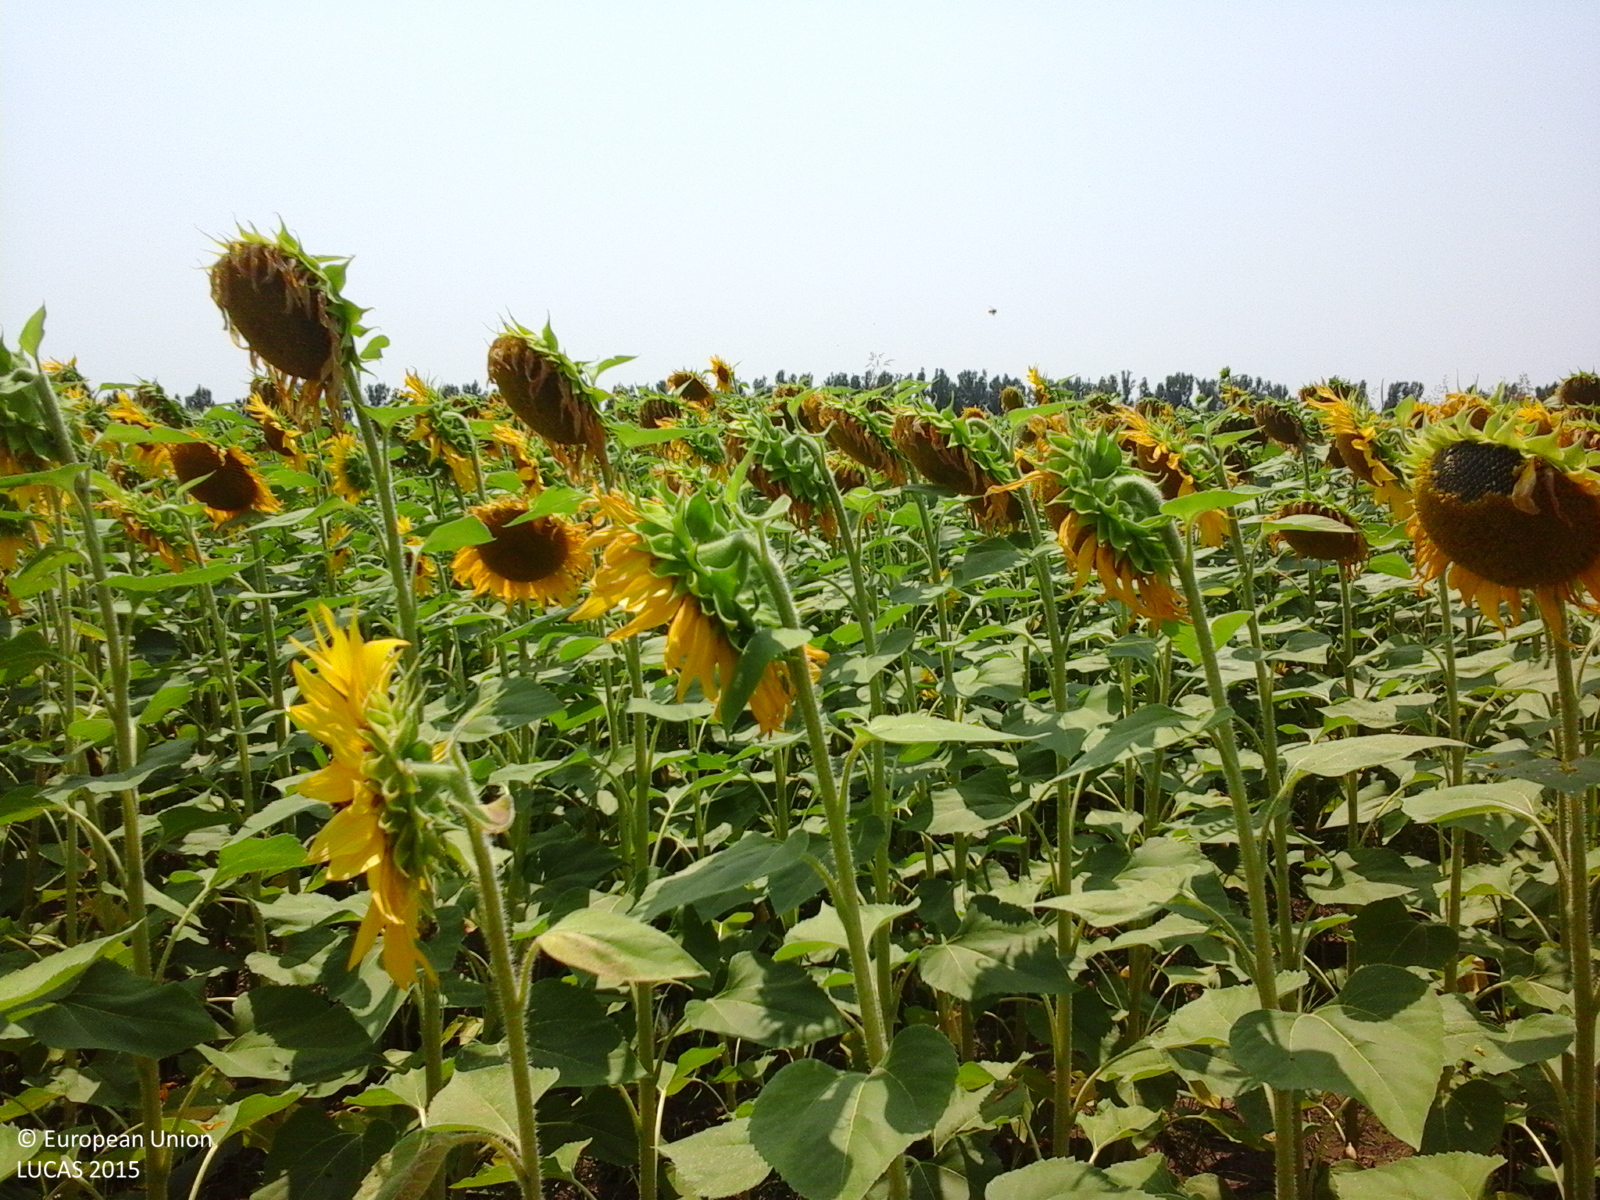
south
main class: Cropland
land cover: Sunflower
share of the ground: > 75 %
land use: Agriculture (excluding fallow land and kitchen gardens)
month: July
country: RO
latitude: 44.7251
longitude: 26.2860
